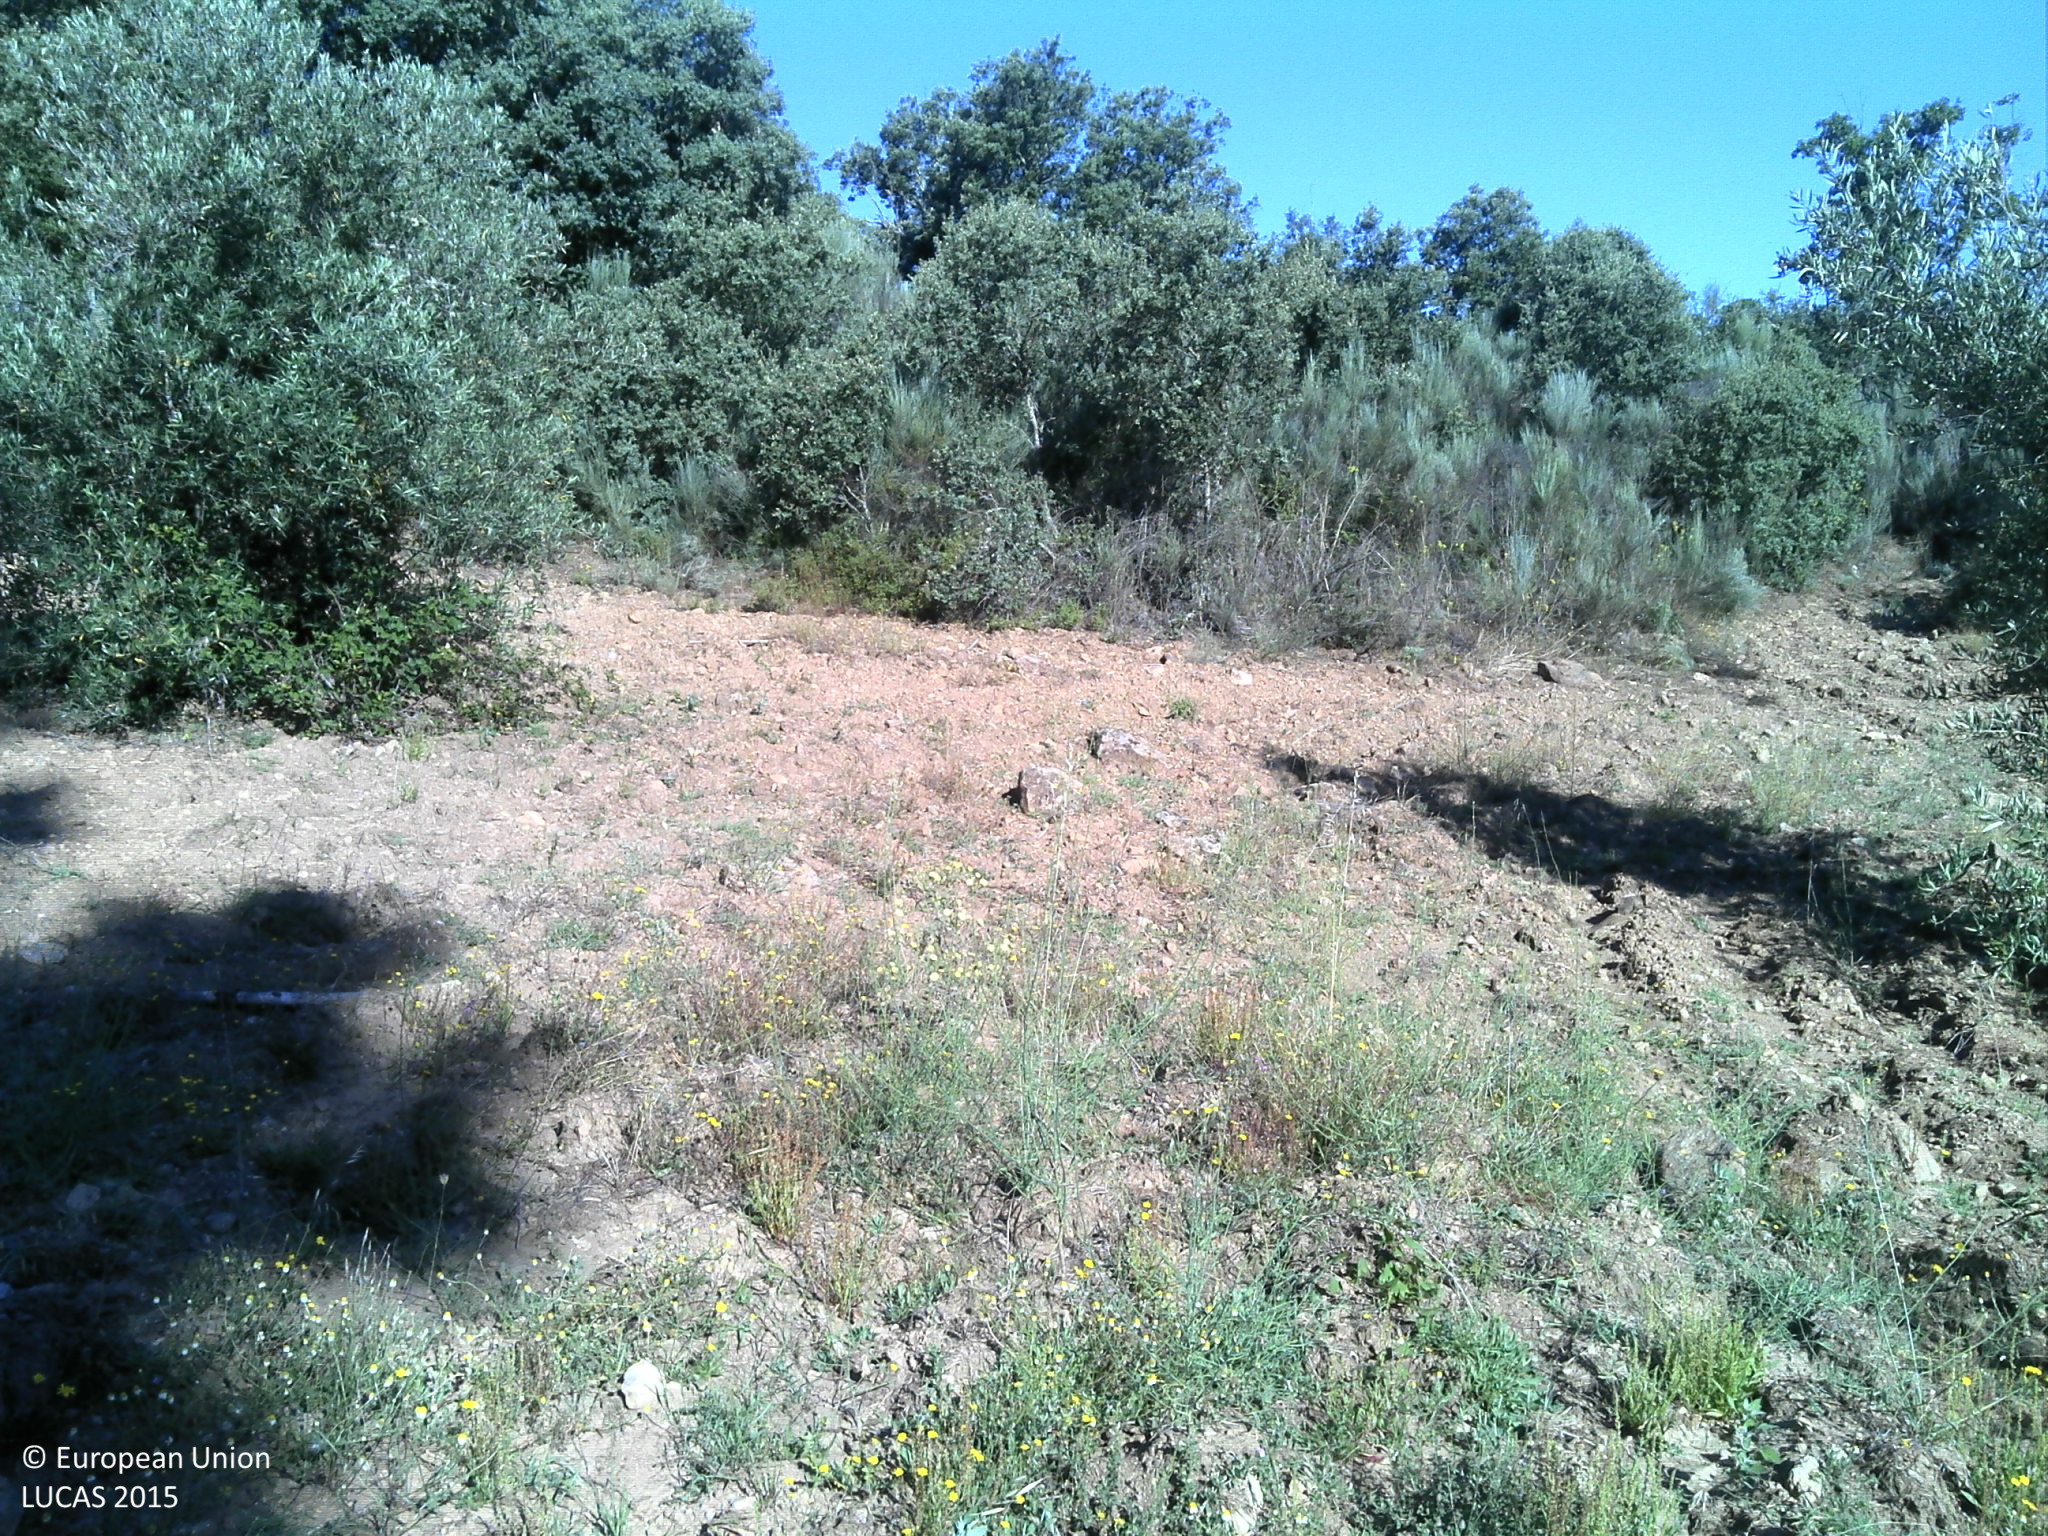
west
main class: Cropland
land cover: Olive groves
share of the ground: < 10 %
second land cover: Spontaneously vegetated surfaces
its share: 10 - 25 %
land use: Agriculture (excluding fallow land and kitchen gardens)
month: June
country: PT
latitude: 40.8597
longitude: -7.1804
